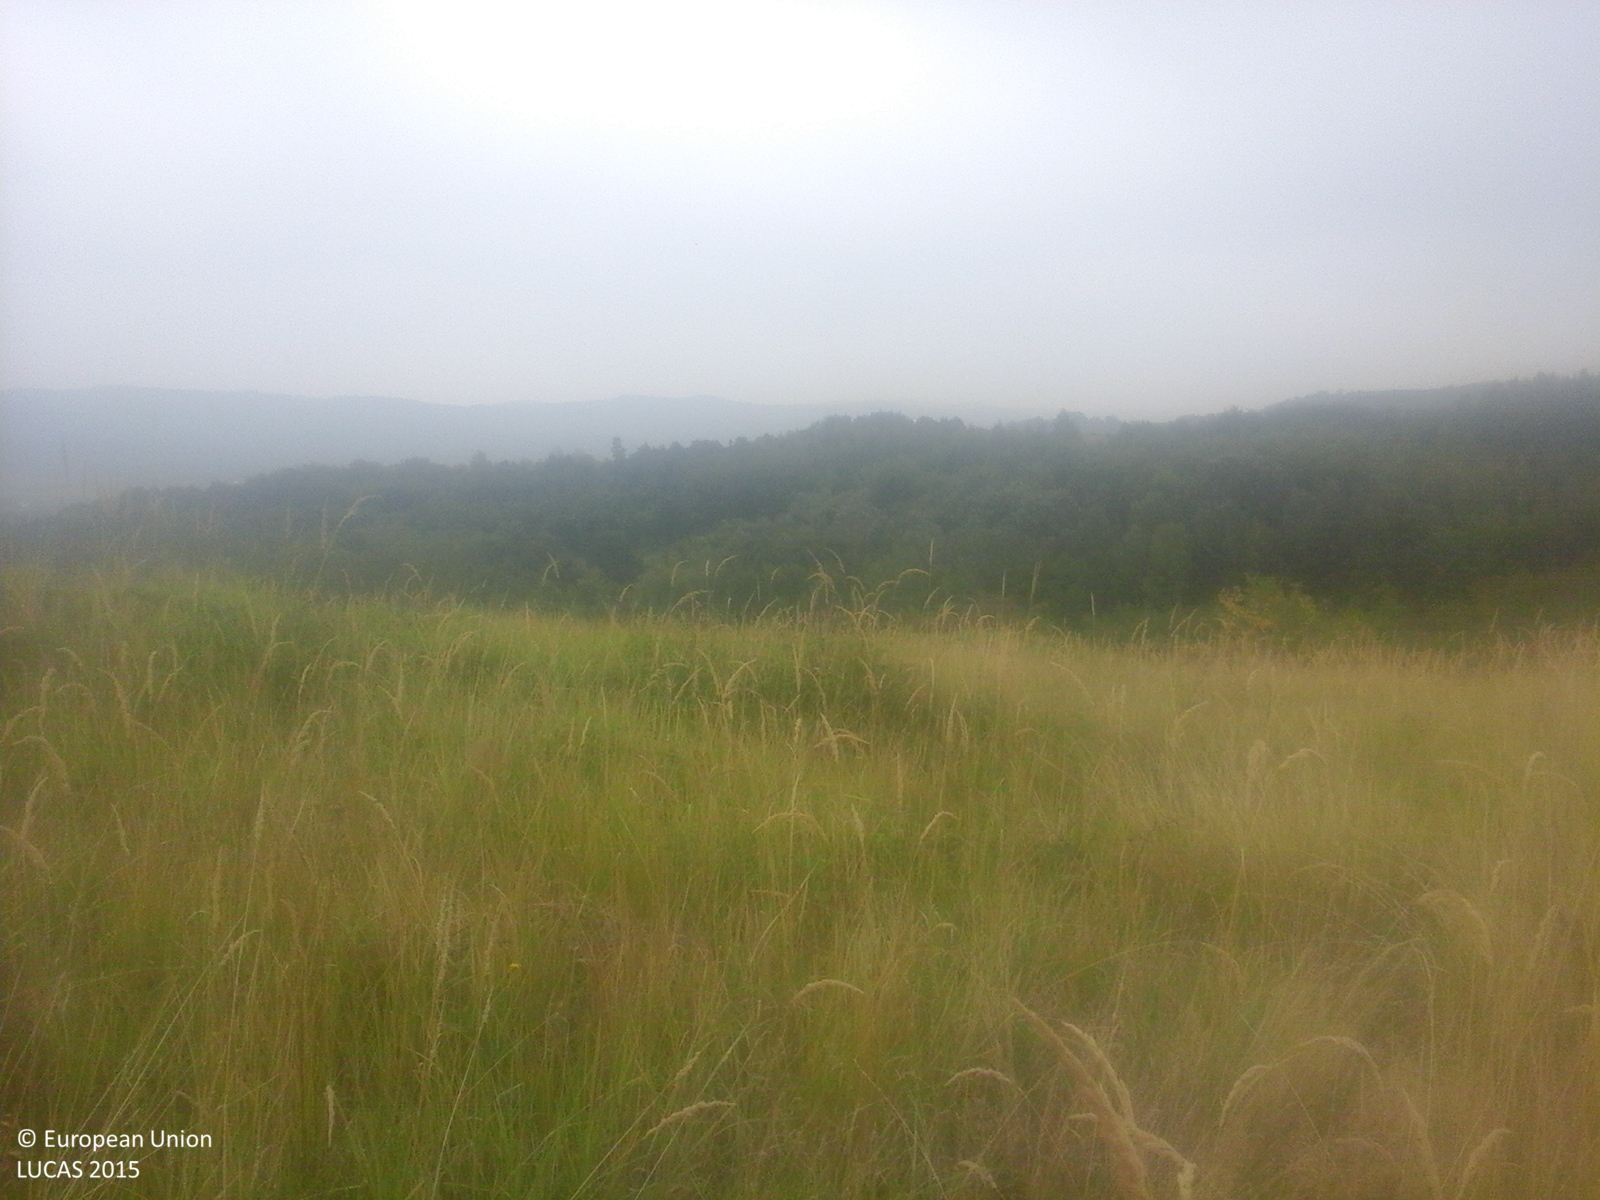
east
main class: Grassland
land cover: Spontaneously vegetated surfaces
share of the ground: > 75 %
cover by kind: herbaceous plants 100 %
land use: Fallow land
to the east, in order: Spontaneously vegetated surfaces; Shrubland without tree cover; Tracks; Shrubland without tree cover; Broadleaved woodland
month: September
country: RO
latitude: 44.7446
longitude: 23.1981
